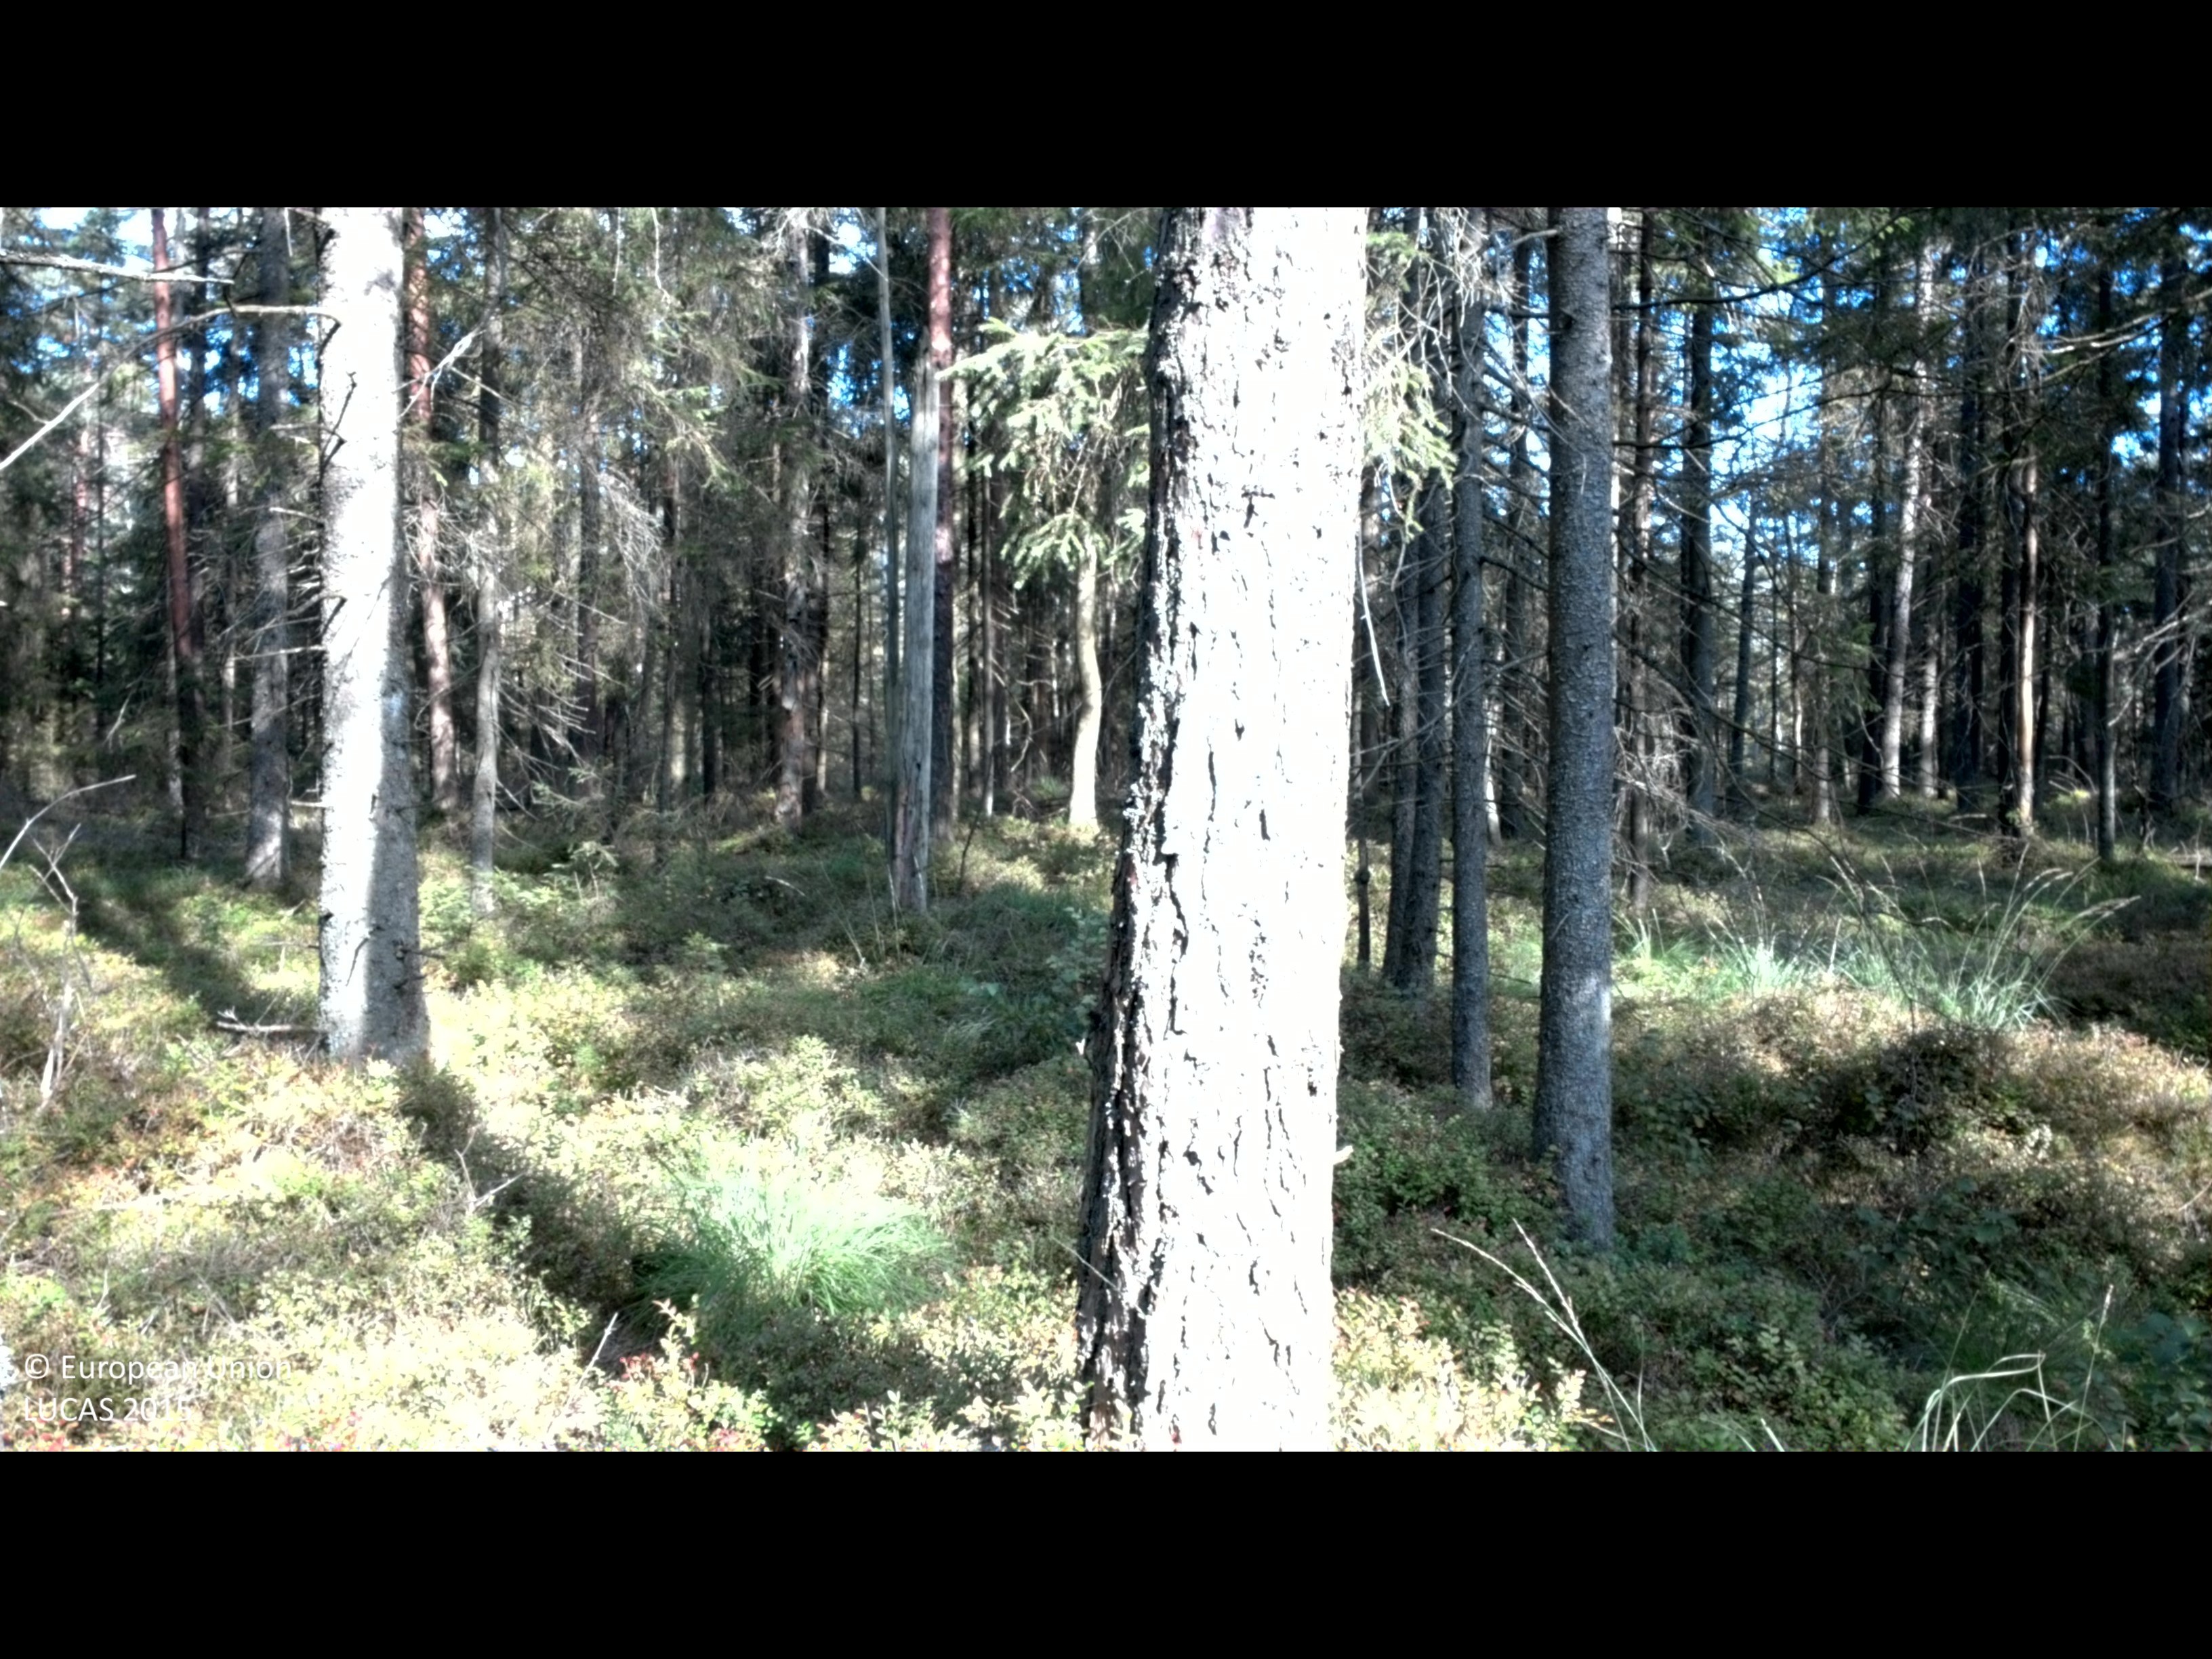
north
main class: Woodland
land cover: Spruce dominated coniferous woodland
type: boreal forest
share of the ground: 50 - 75 %
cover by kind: coniferous forest trees 65 %, shrubs 25 %, broadleaved forest trees 5 %, herbaceous plants 5 %
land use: Forestry
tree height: > 5 m
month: September
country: SE
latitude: 56.8147
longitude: 13.1582
